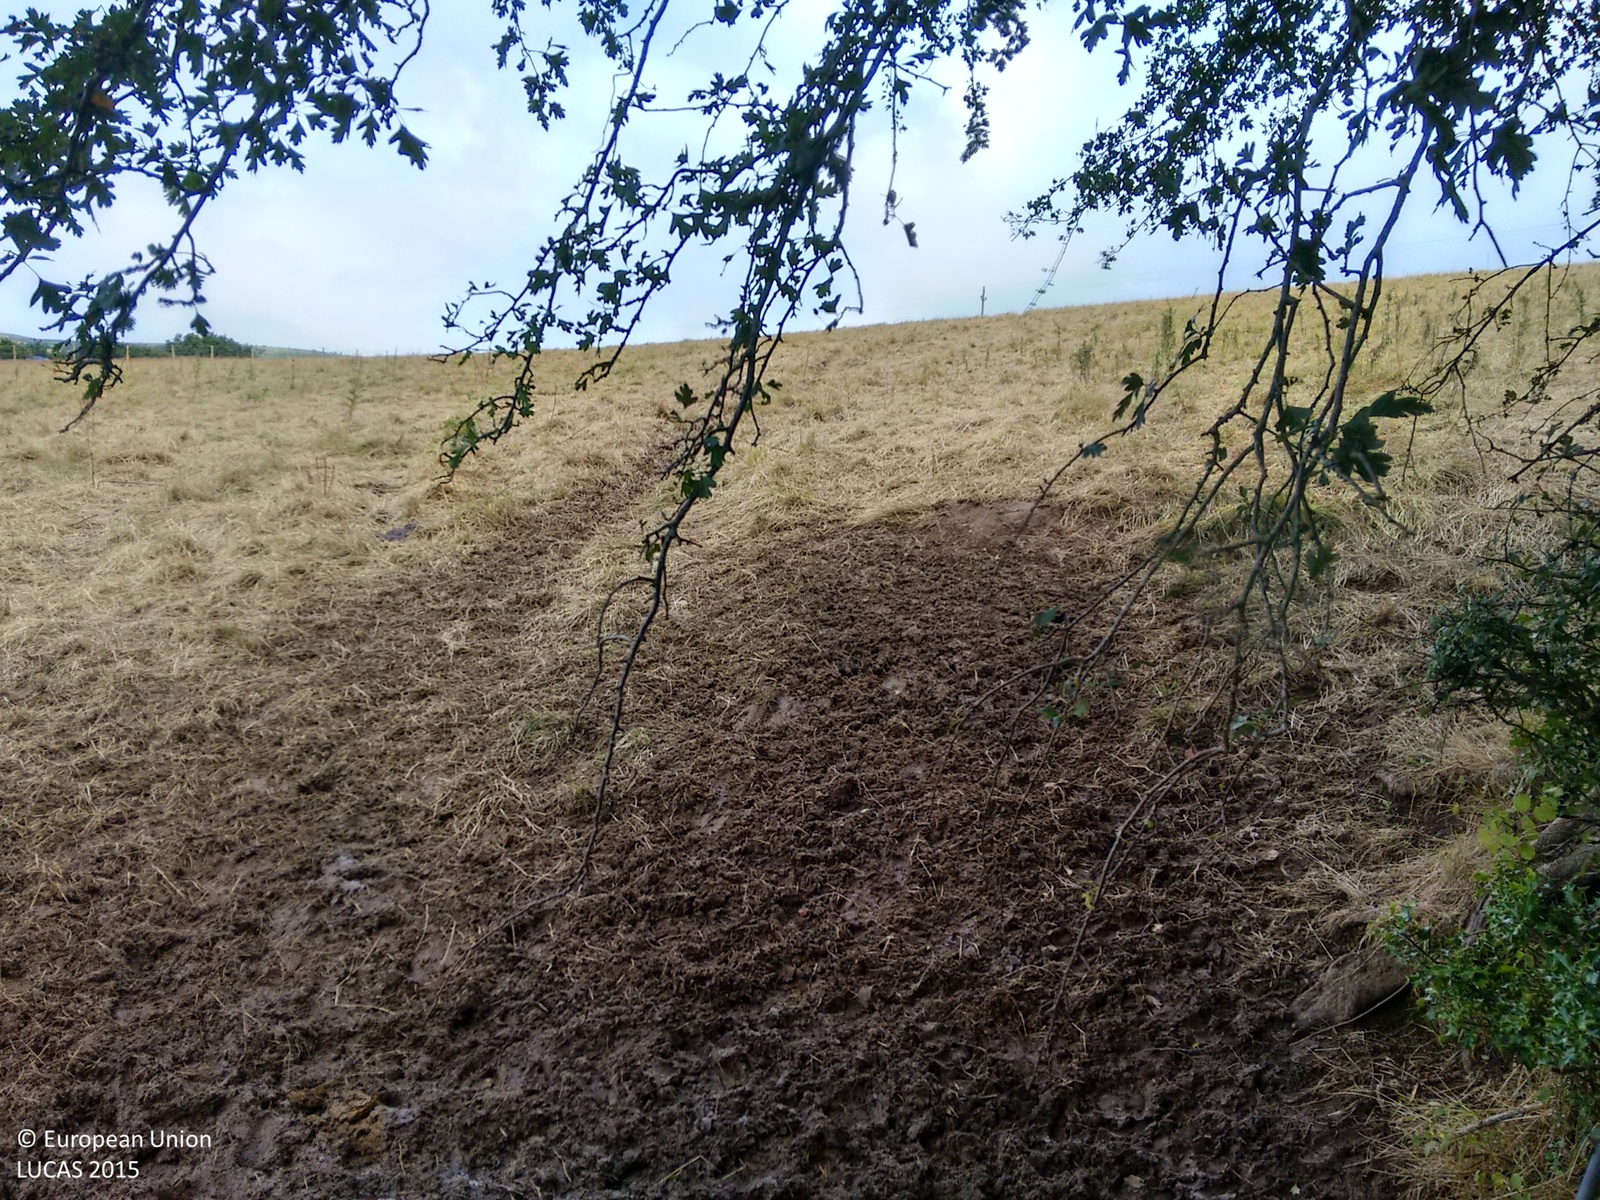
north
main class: Grassland
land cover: Grassland without tree/shrub cover
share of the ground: > 75 %
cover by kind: herbaceous plants 100 %
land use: Agriculture (excluding fallow land and kitchen gardens)
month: July
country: GB
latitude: 50.5729
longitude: -3.7139
